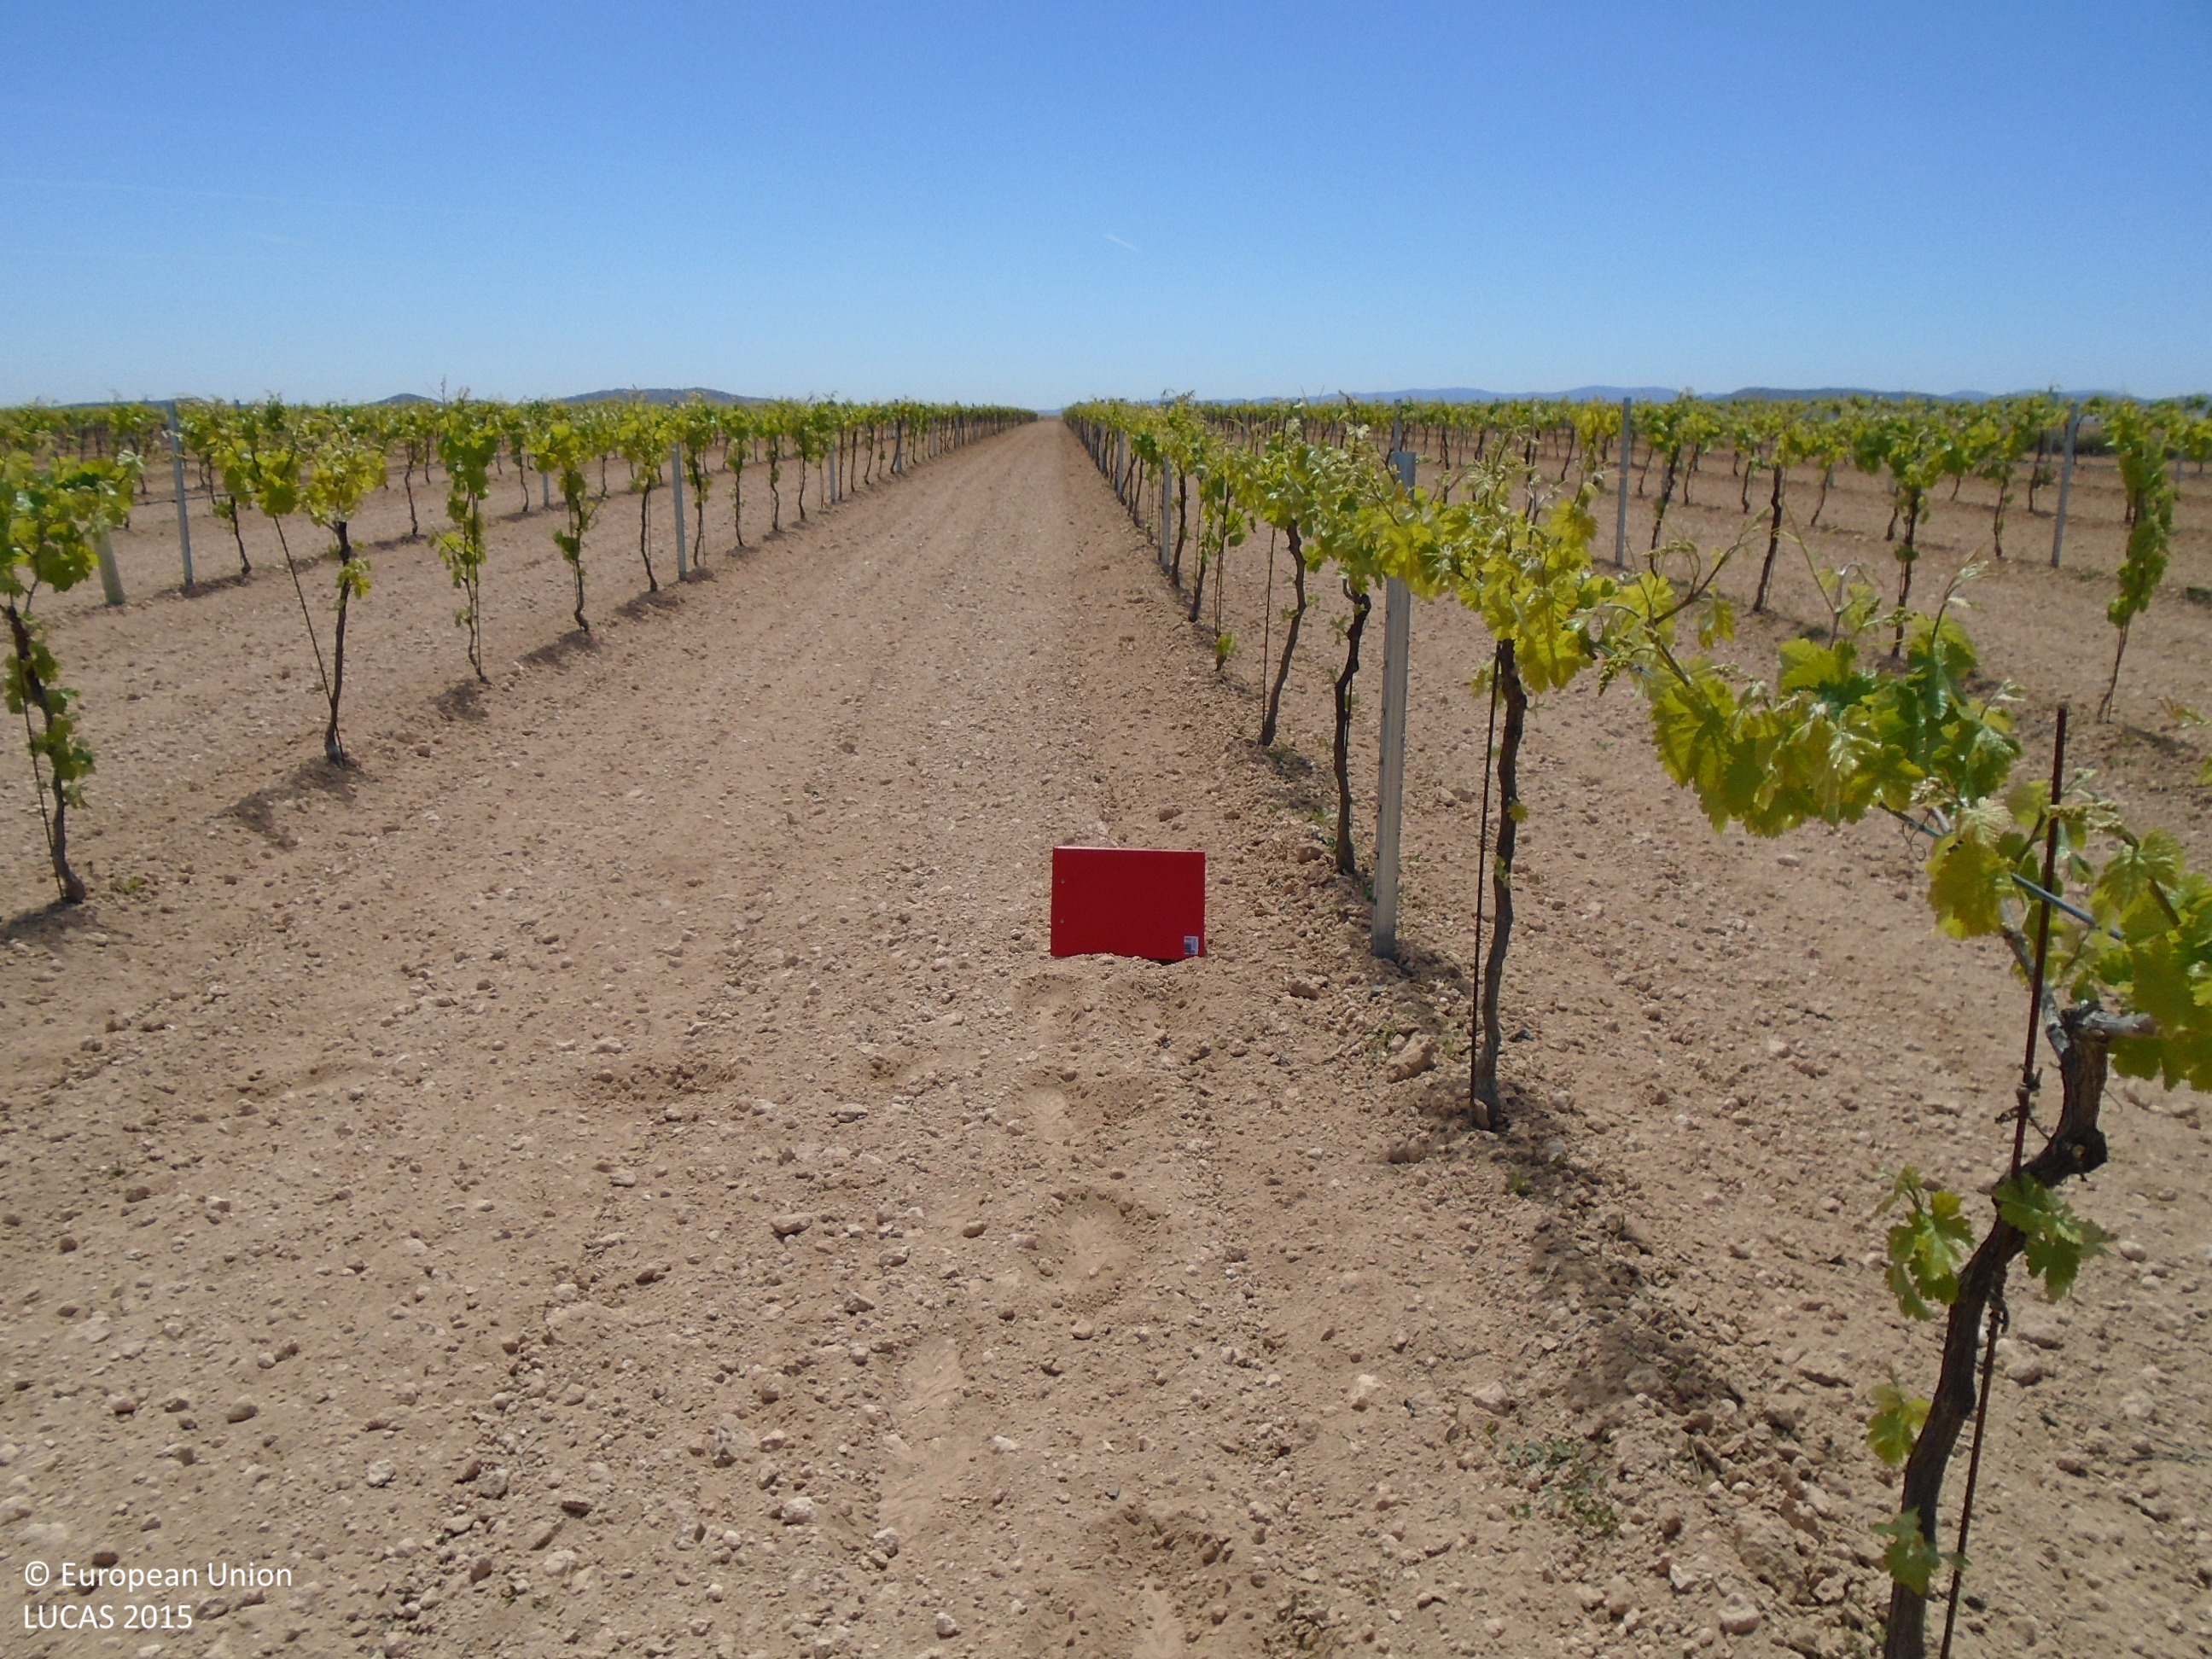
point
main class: Cropland
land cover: Vineyards
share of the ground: 10 - 25 %
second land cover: Other bare soil
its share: > 75 %
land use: Agriculture (excluding fallow land and kitchen gardens)
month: May
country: ES
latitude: 39.5819
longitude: -3.6592
